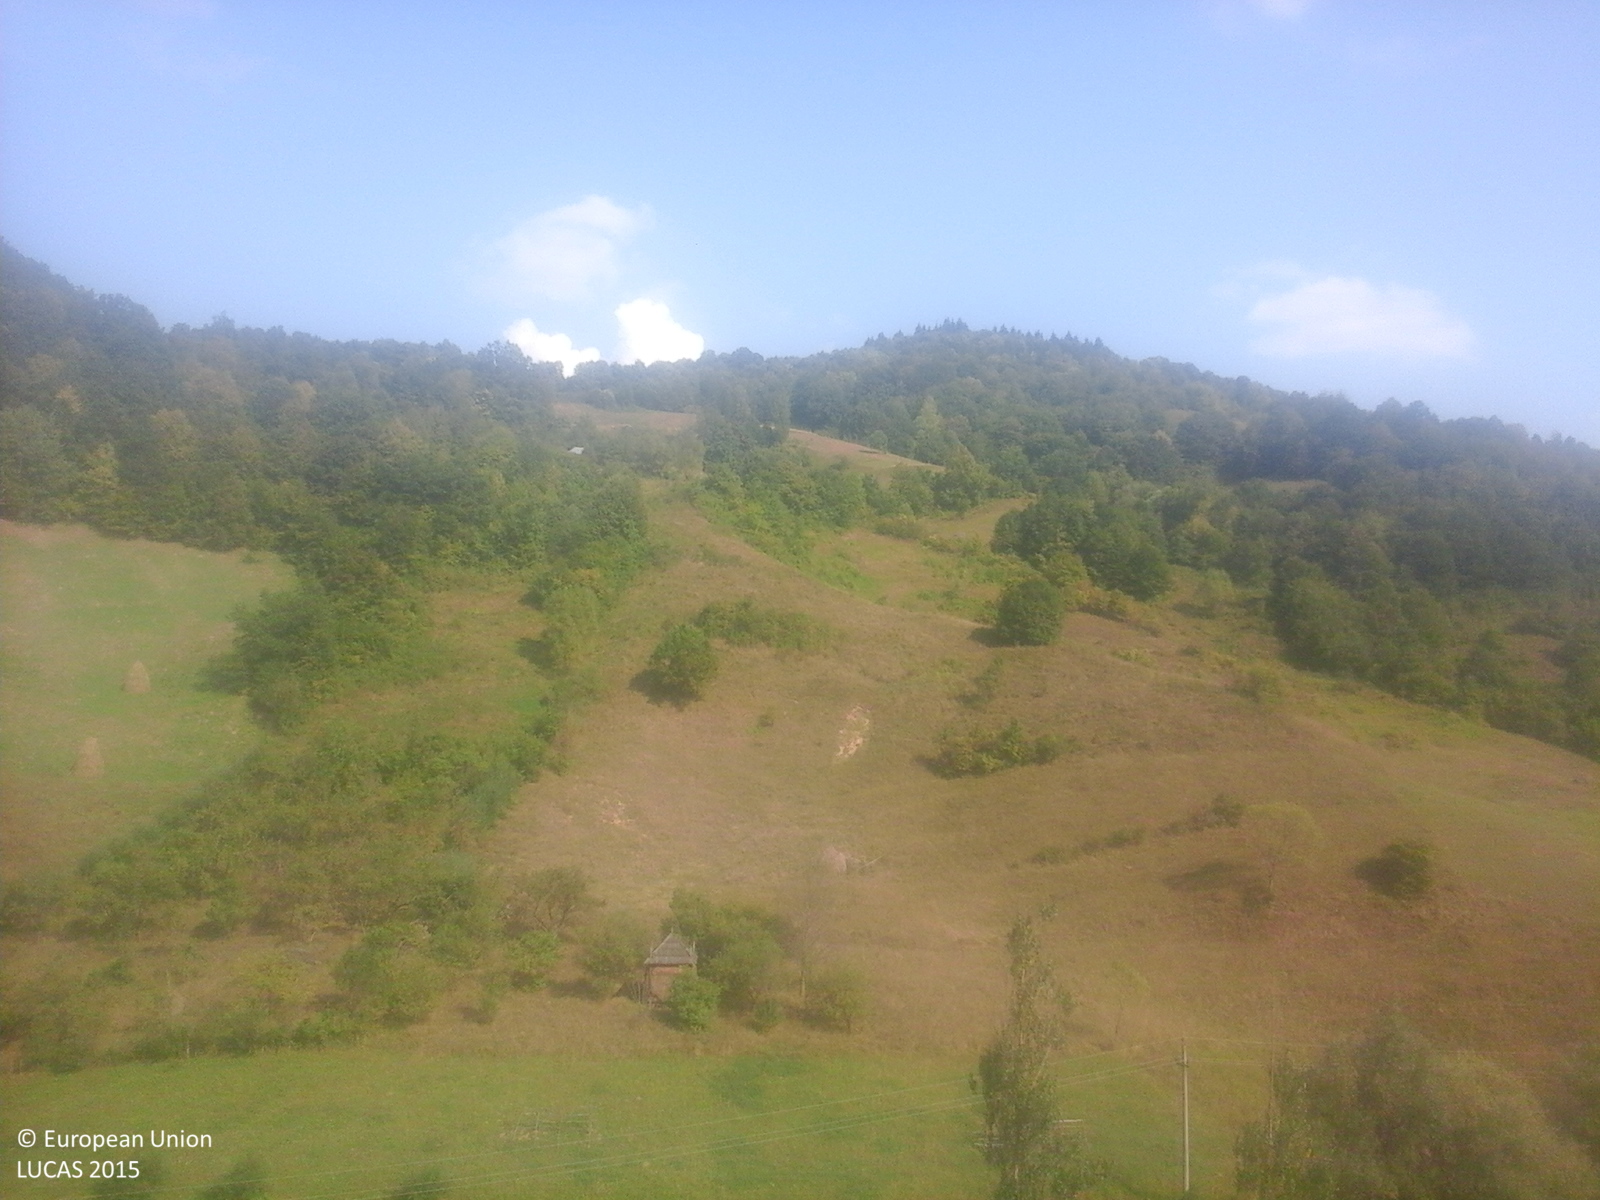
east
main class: Grassland
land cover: Grassland with sparse tree/shrub cover
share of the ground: > 75 %
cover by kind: herbaceous plants 85 %, shrubs 10 %, broadleaved forest trees 5 %
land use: Agriculture (excluding fallow land and kitchen gardens)
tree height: < 5 m
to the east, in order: Grassland with sparse tree/shrub cover; Grassland without tree/shrub cover; Abandoned hedges; Tracks; Shruby margins; Paved roads, cycling and walking lanes; Shruby margins; Electric lines; Fences; Grassland without tree/shrub cover; Abandoned hedges; Ditches and canals; Abandoned hedges; Grassland without tree/shrub cover; Electric lines; Grassland without tree/shrub cover; Apple fruit; Grassland with sparse tree/shrub cover; Broadleaved woodland
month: September
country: RO
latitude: 47.7217
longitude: 24.3154
